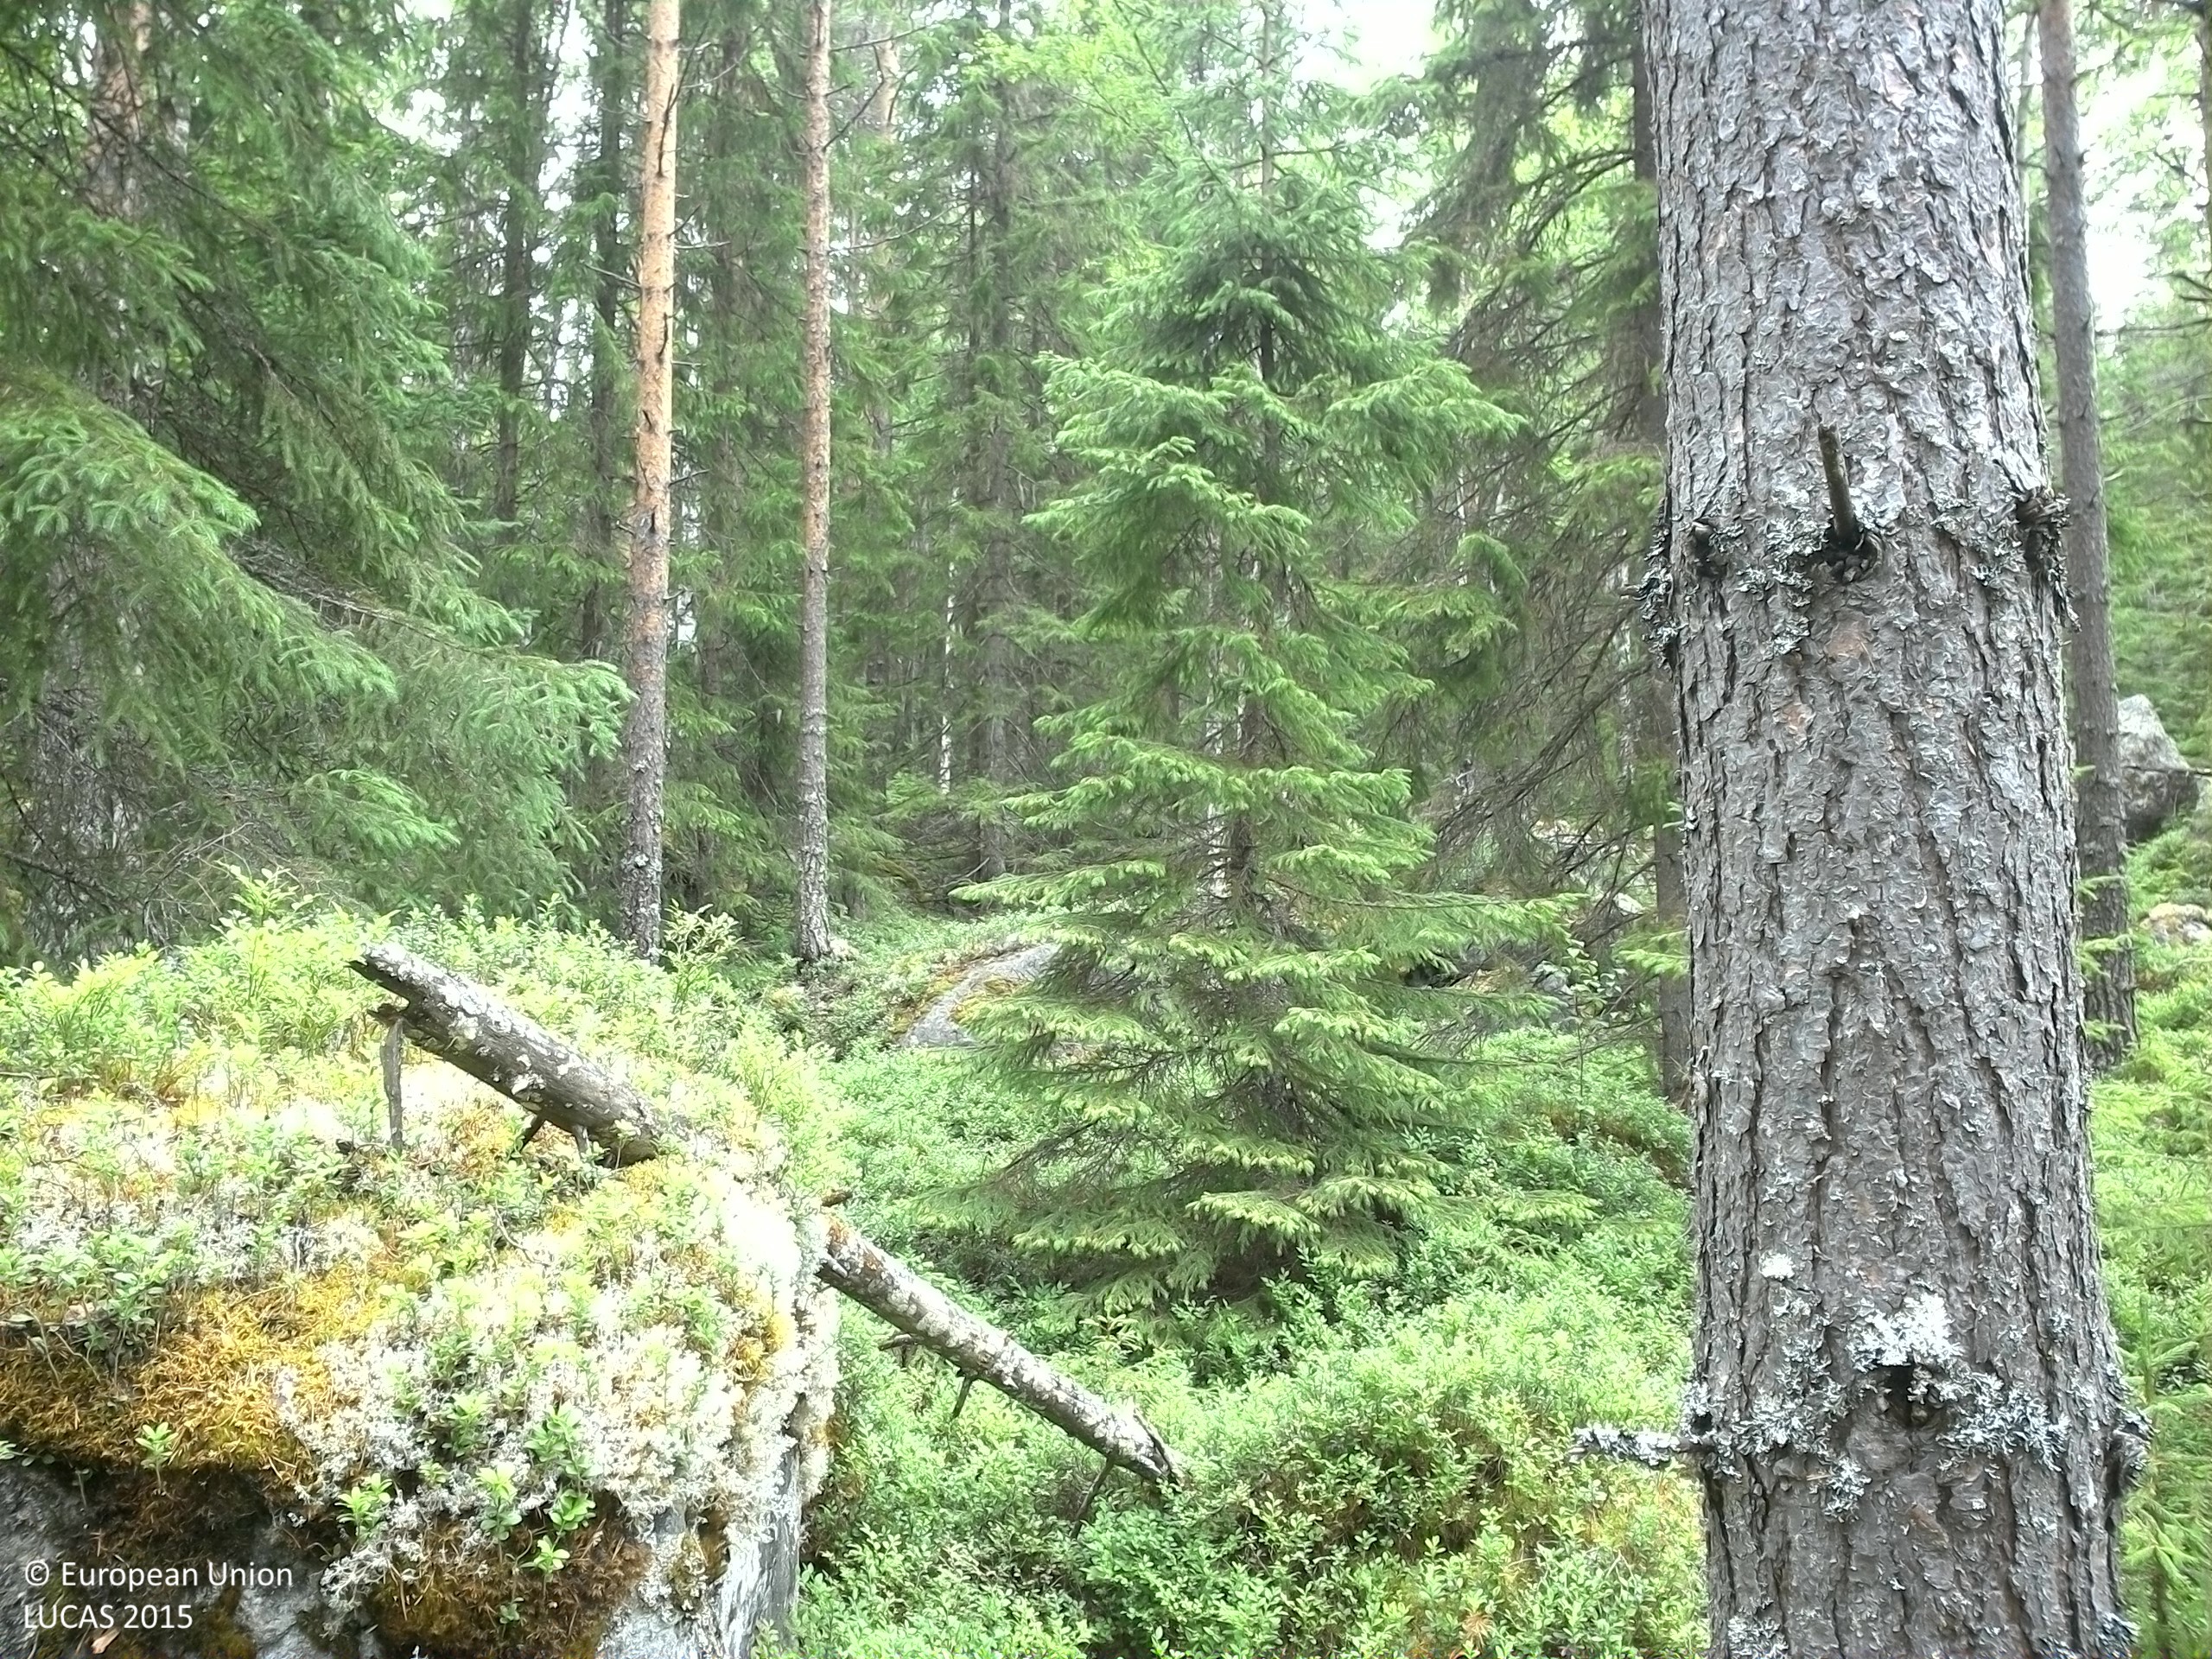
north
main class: Woodland
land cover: Pine dominated coniferous woodland
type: boreal forest
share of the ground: 50 - 75 %
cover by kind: coniferous forest trees 50 %, shrubs 30 %, lichens and mosses 10 %, broadleaved forest trees 5 %, herbaceous plants 5 %
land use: Forestry
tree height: > 5 m
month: July
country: SE
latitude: 62.7176
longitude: 17.0768
